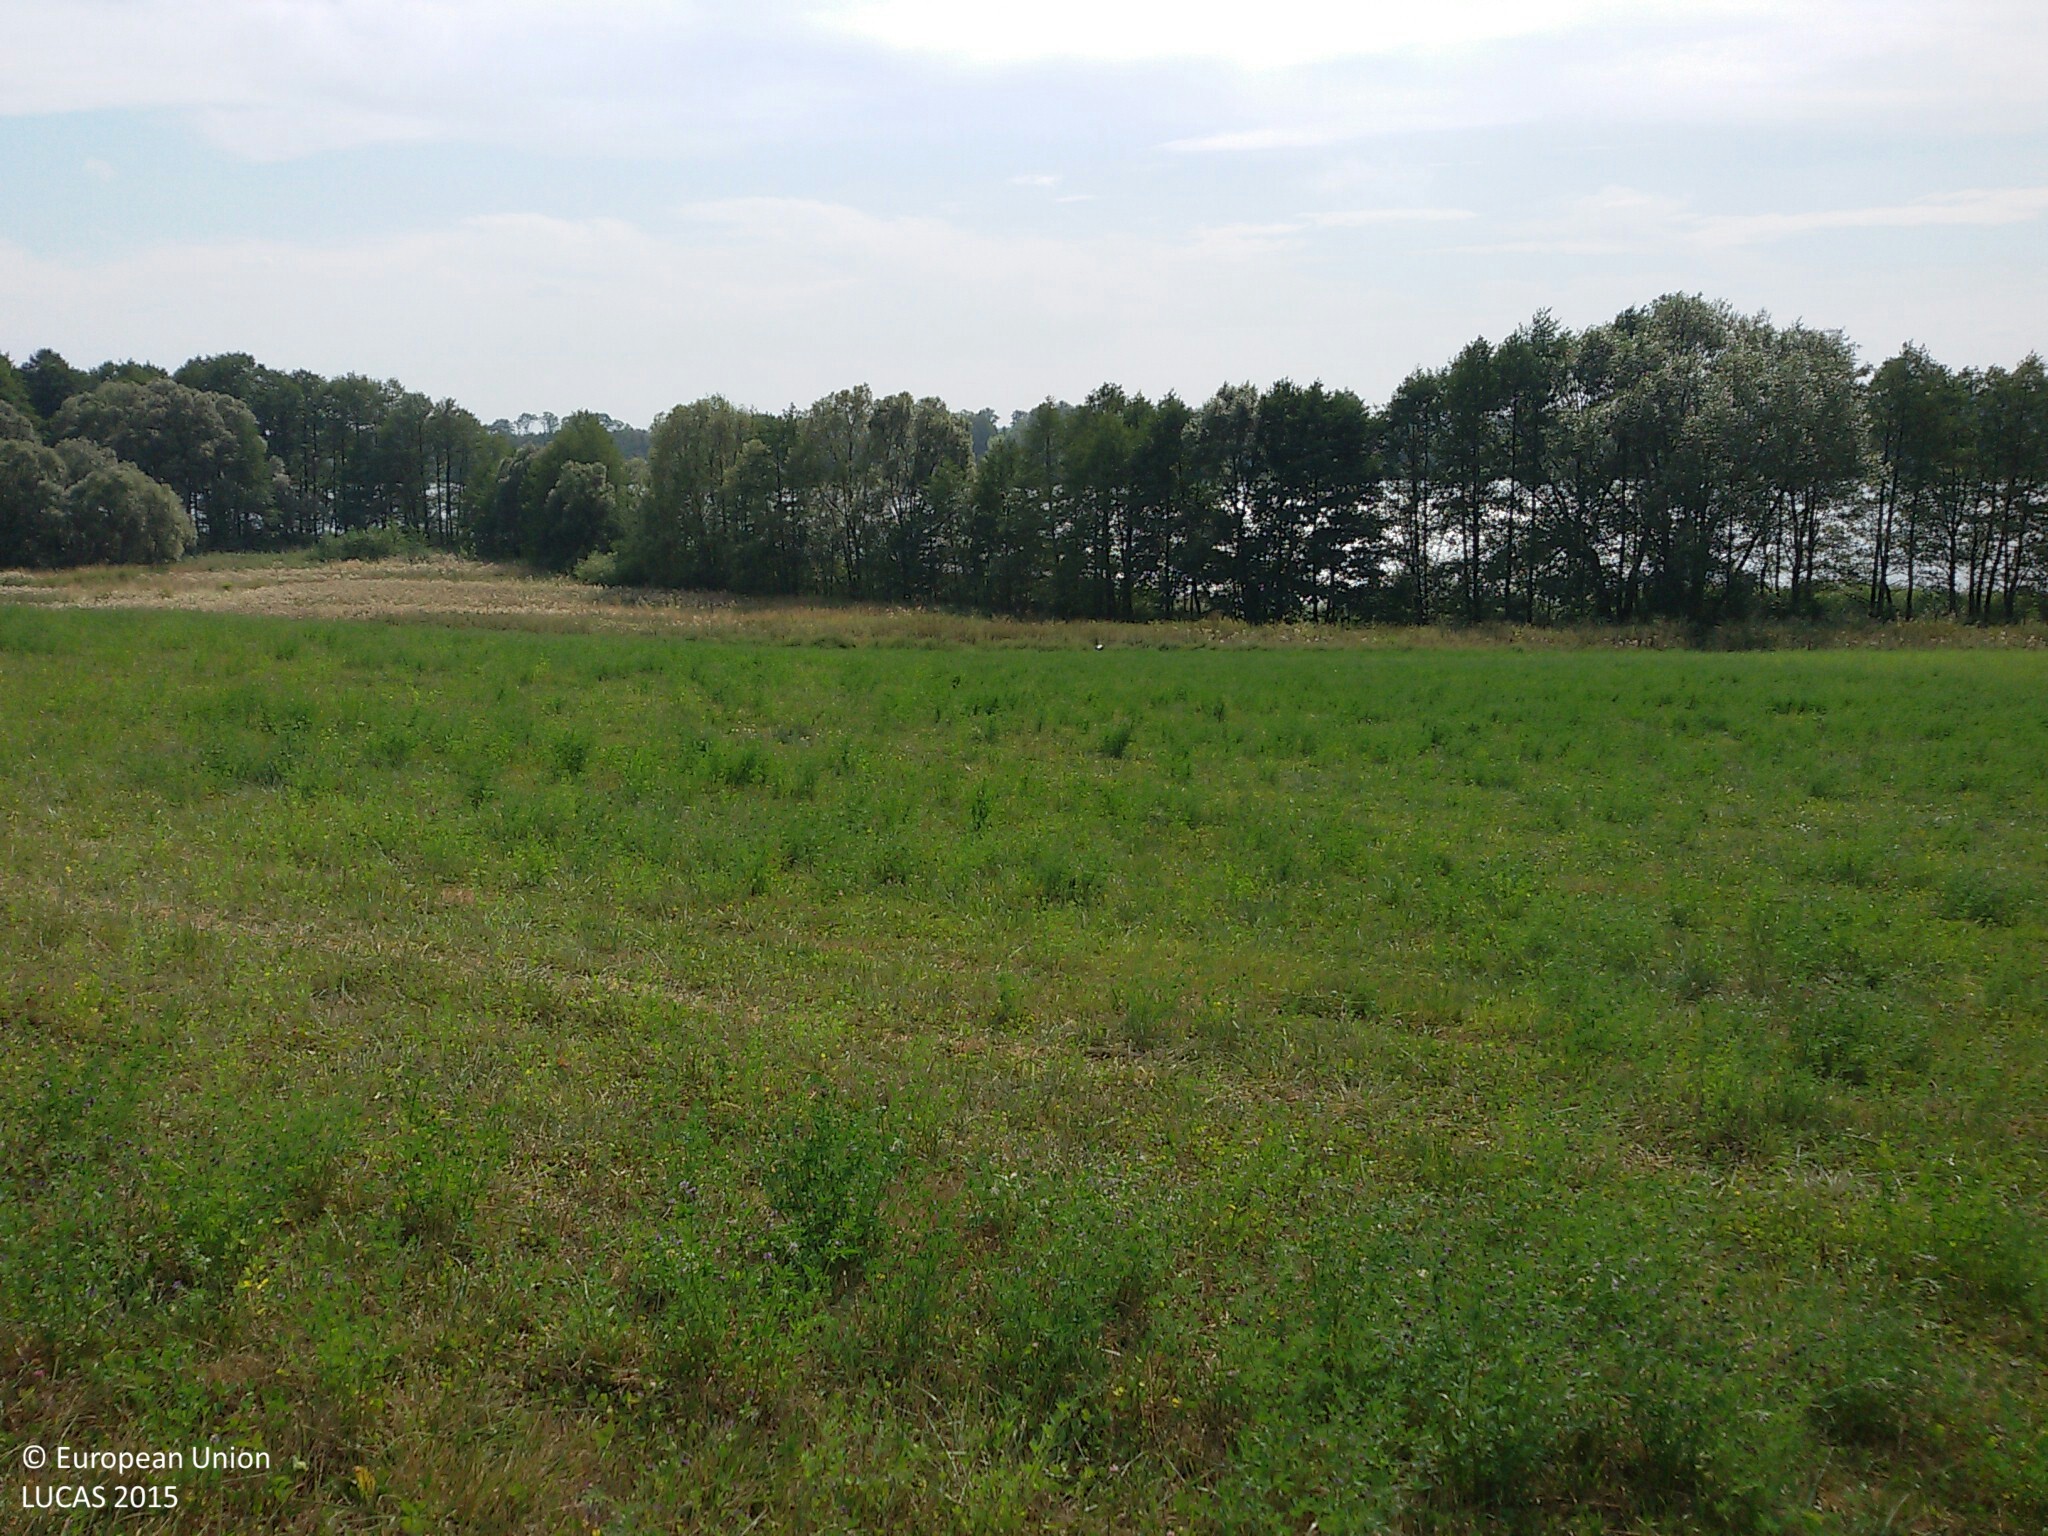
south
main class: Grassland
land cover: Grassland without tree/shrub cover
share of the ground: > 75 %
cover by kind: herbaceous plants 100 %
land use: Agriculture (excluding fallow land and kitchen gardens)
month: August
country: PL
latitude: 53.6067
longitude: 20.1746
